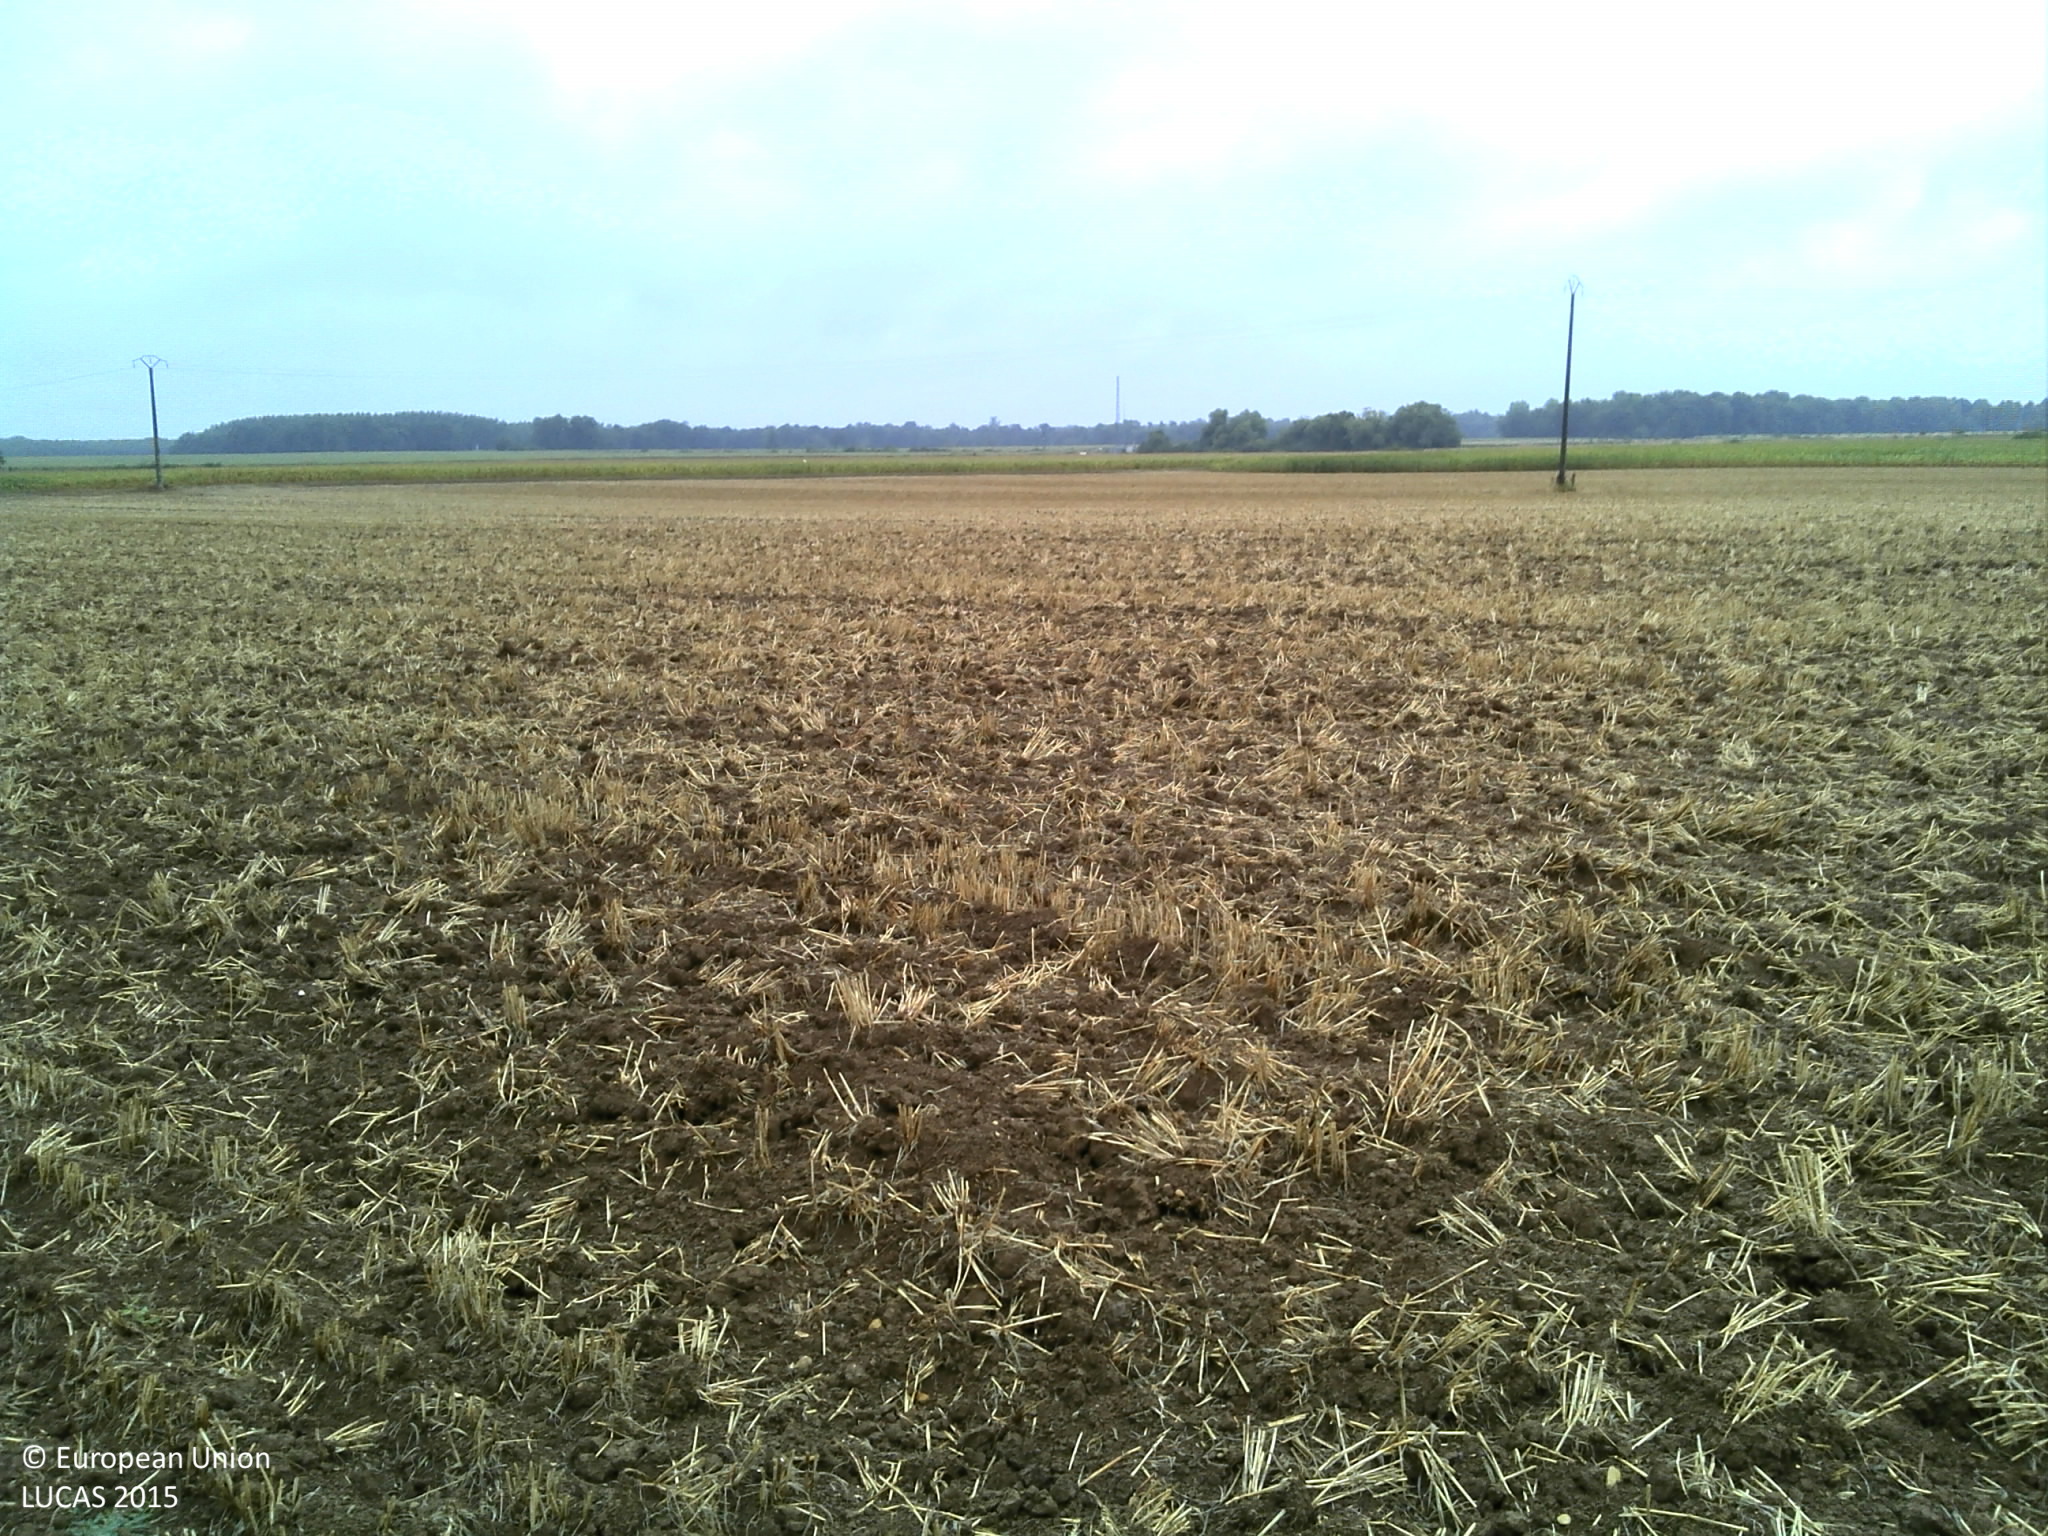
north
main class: Cropland
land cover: Common wheat
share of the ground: > 75 %
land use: Agriculture (excluding fallow land and kitchen gardens)
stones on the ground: < 10 %
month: August
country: FR
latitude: 48.6802
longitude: 4.8503
